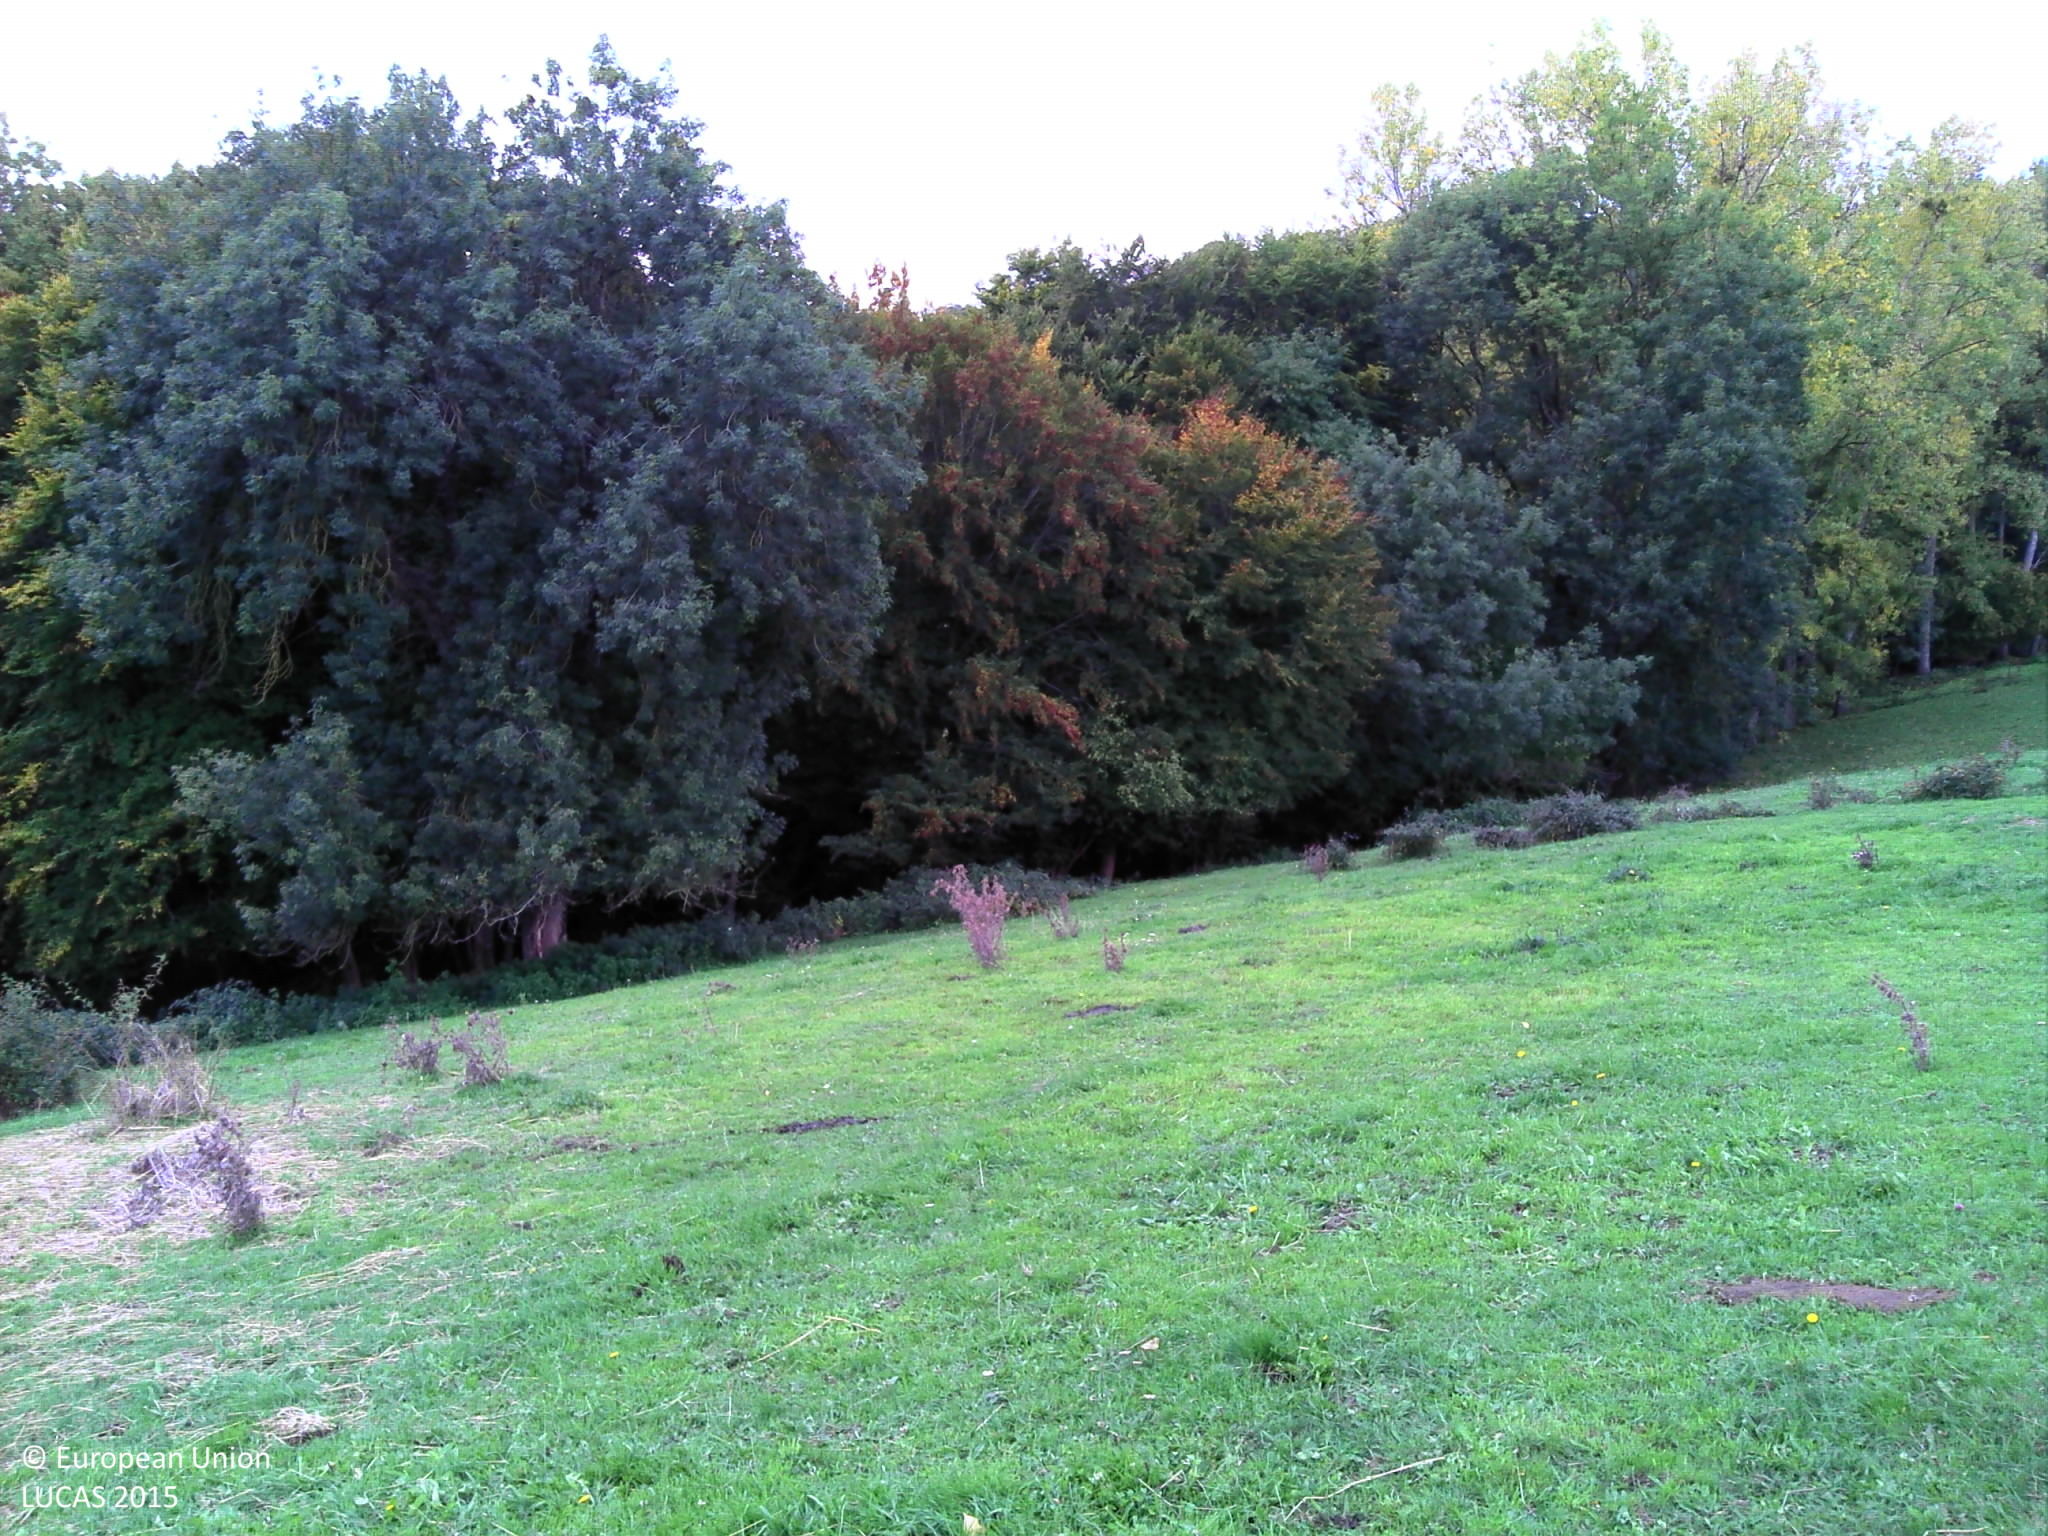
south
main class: Grassland
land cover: Grassland without tree/shrub cover
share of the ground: > 75 %
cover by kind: herbaceous plants 100 %
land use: Agriculture (excluding fallow land and kitchen gardens)
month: October
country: FR
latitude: 46.0857
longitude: 3.0020
